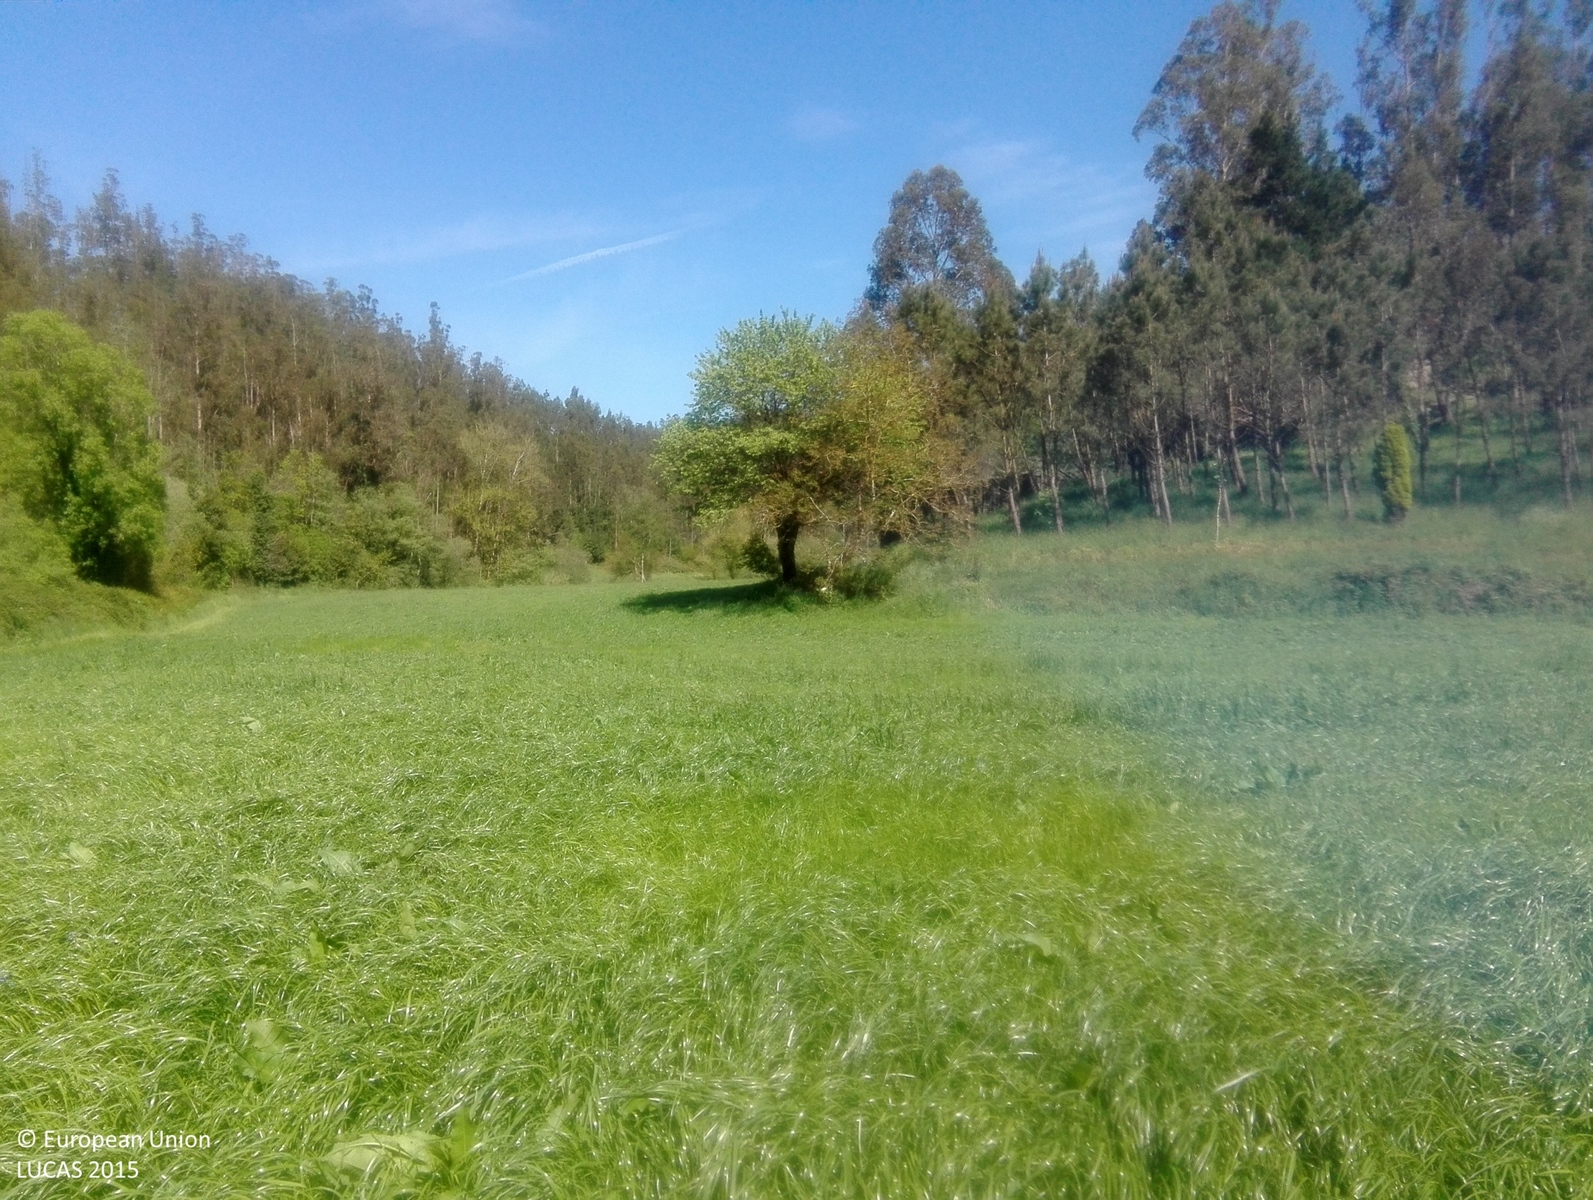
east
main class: Cropland
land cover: Temporary grasslands
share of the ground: > 75 %
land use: Agriculture (excluding fallow land and kitchen gardens)
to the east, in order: Temporary grasslands; Electric lines; Temporary grasslands; Grass margins; Tracks; Broadleaved woodland; Shrubland without tree cover; Grass margins; Tracks; Grass margins; Other bare soil; Temporary grasslands
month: April
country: ES
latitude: 43.4327
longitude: -7.1058
